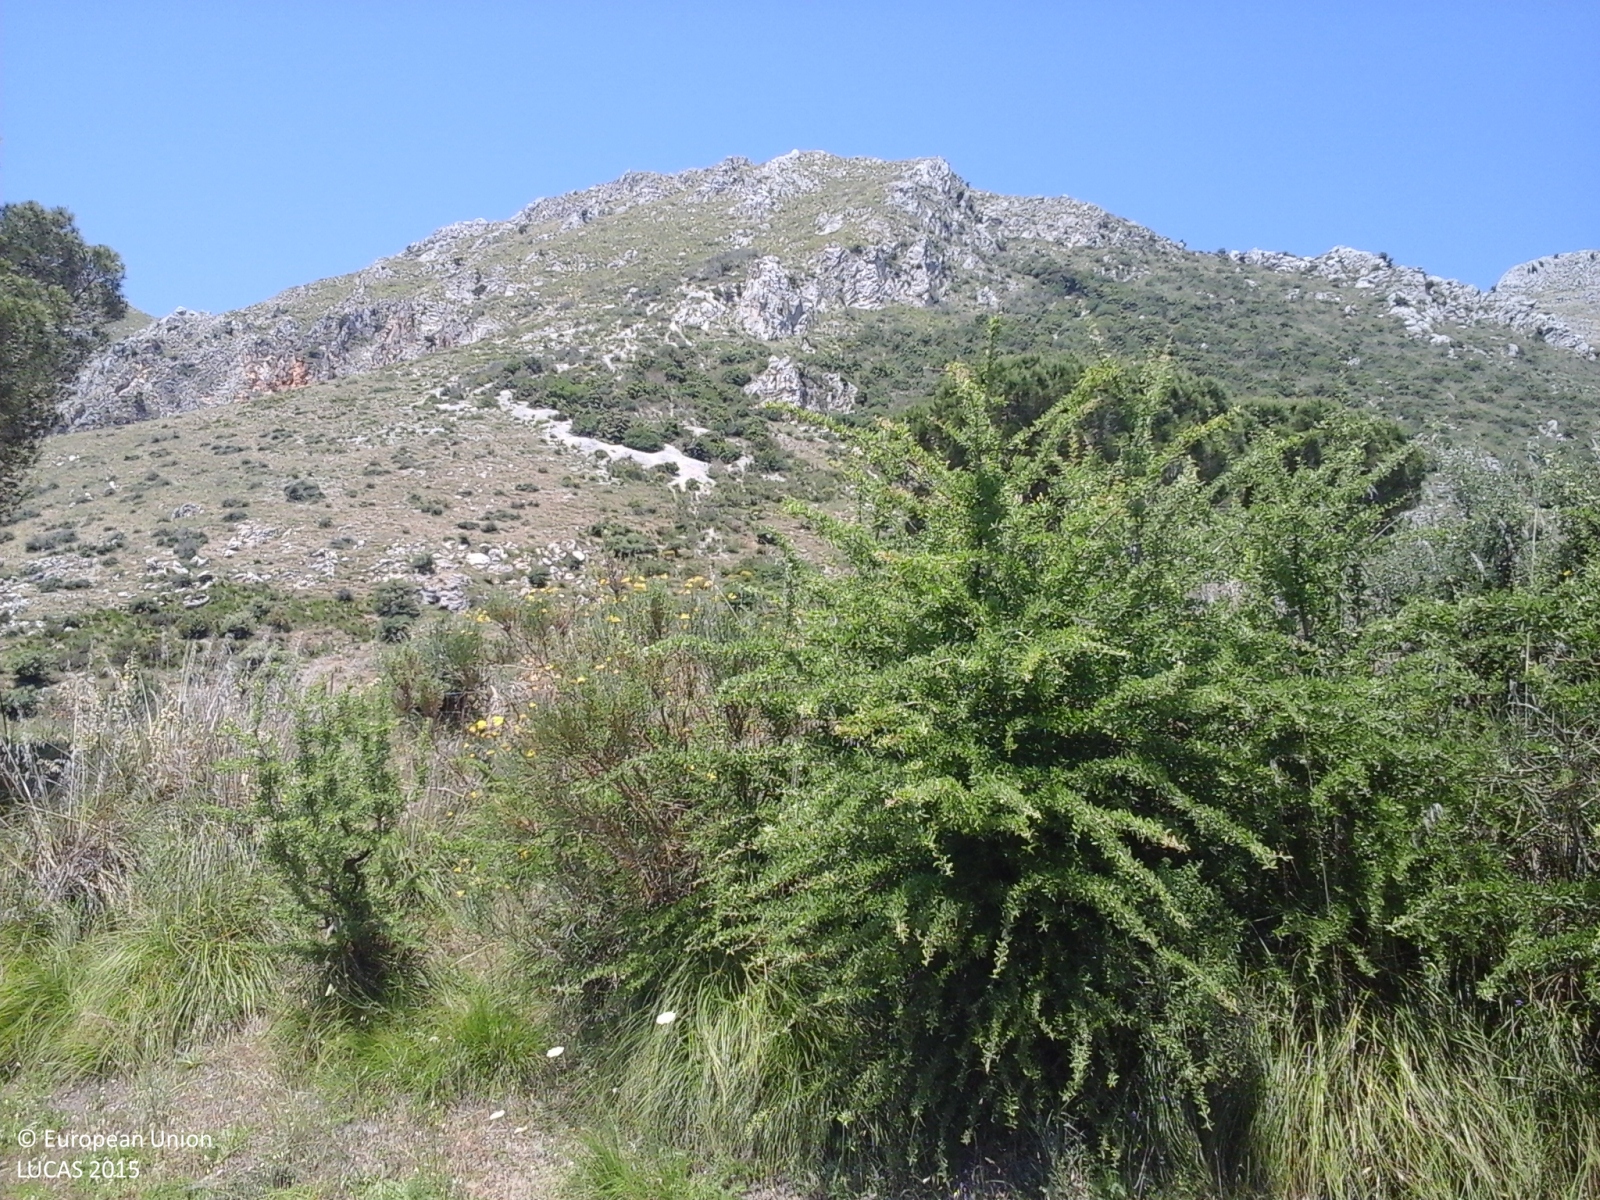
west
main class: Shrubland
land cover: Shrubland with sparse tree cover
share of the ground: > 75 %
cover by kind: shrubs 55 %, herbaceous plants 40 %, broadleaved forest trees 5 %
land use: Agriculture (excluding fallow land and kitchen gardens)
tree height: < 5 m
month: June
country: IT
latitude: 37.9536
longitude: 14.0121
